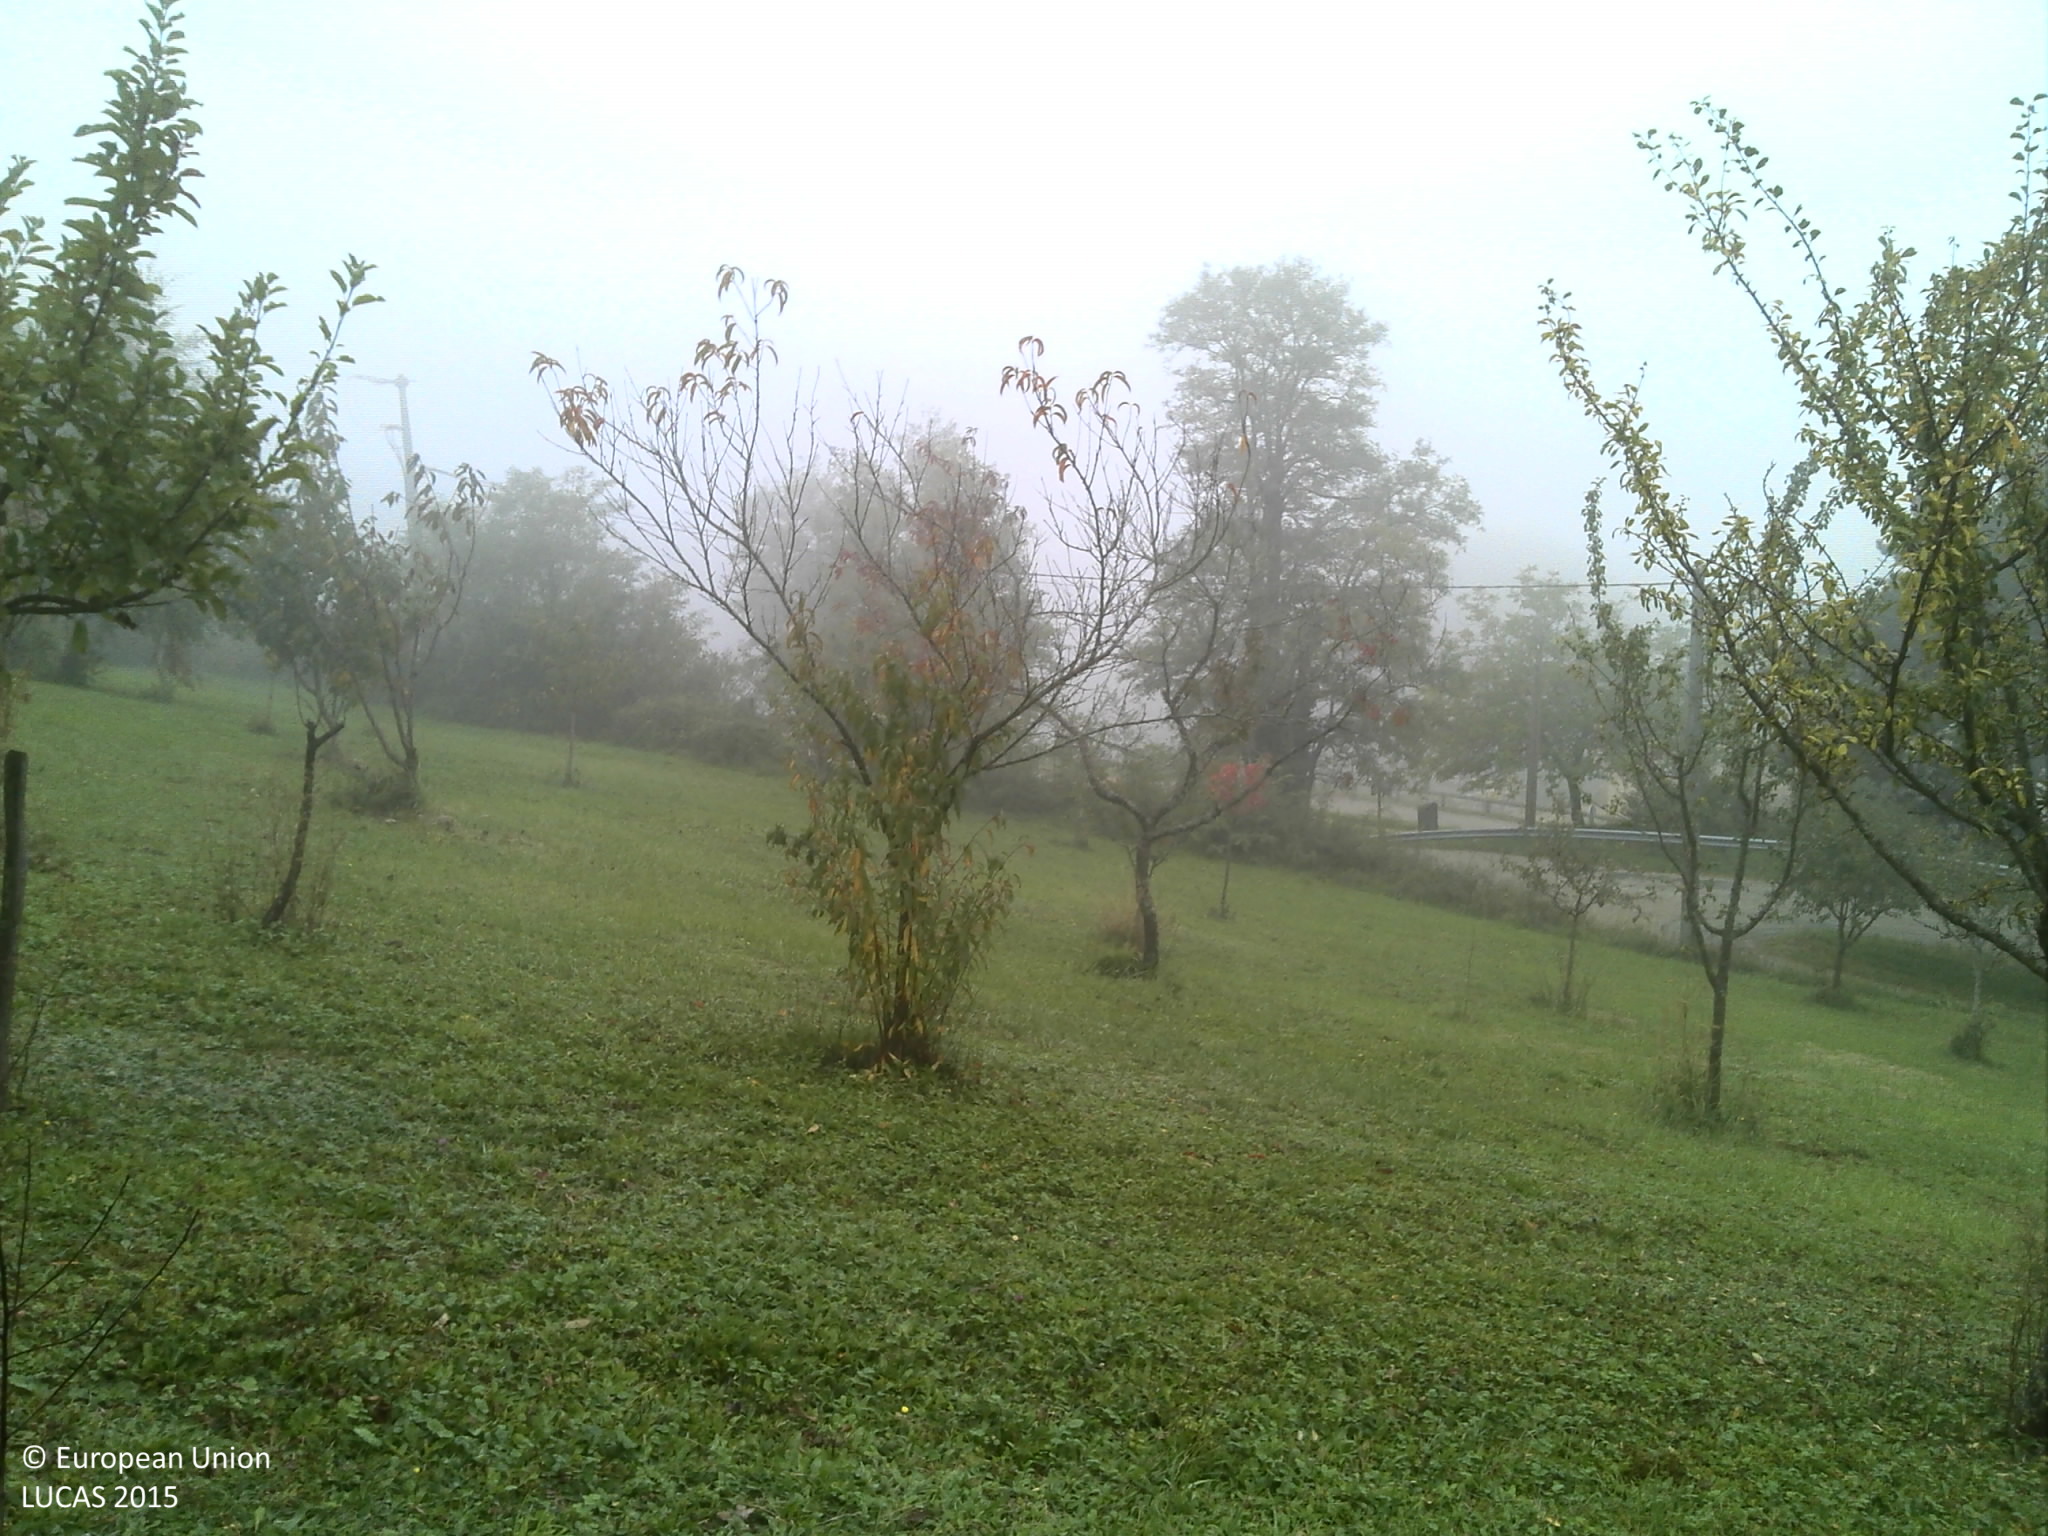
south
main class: Cropland
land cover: Apple fruit
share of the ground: 10 - 25 %
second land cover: Grassland without tree/shrub cover
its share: > 75 %
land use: Kitchen garden
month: October
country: FR
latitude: 46.3769
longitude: 5.3614
